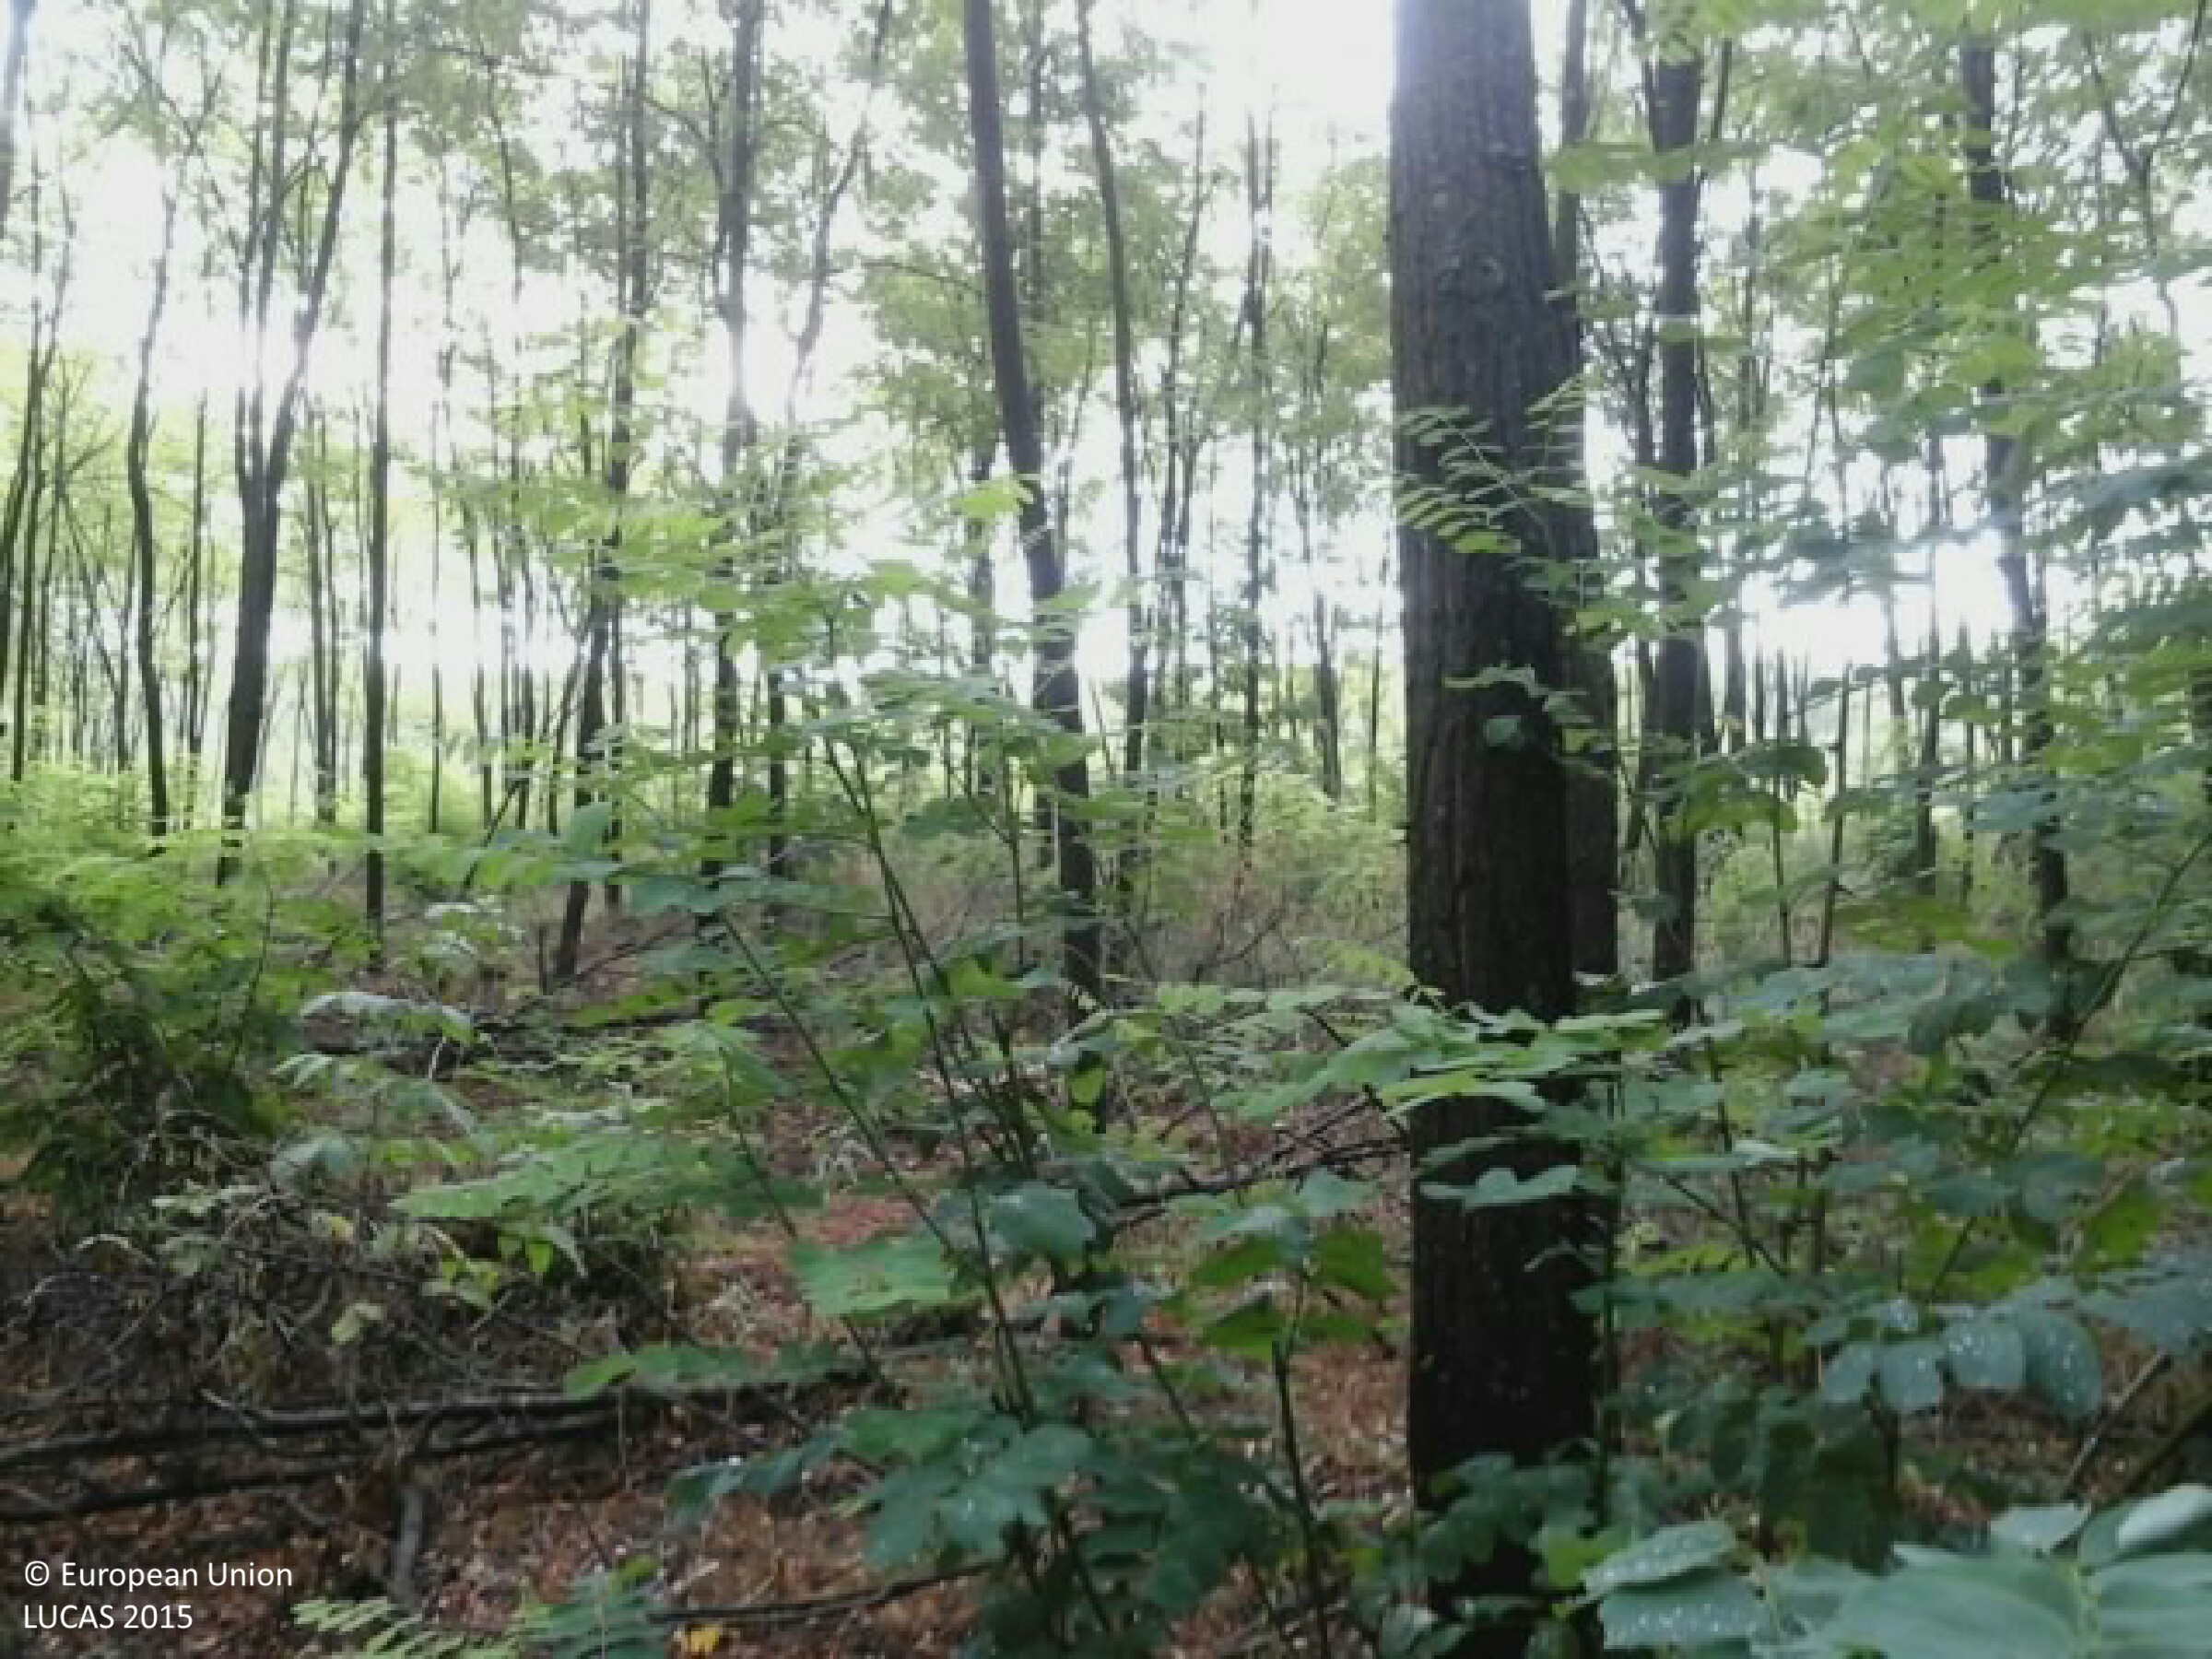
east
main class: Woodland
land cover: Broadleaved woodland
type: exotic forest
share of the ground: > 75 %
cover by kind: broadleaved forest trees 85 %, shrubs 10 %, herbaceous plants 5 %
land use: Forestry
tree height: > 5 m
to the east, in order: Broadleaved woodland; Tracks; Grass margins; Electric lines; Grass margins; Fences; Other fruit trees and berries; Fences; Spontaneously vegetated surfaces; Broadleaved woodland
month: August
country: HU
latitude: 47.1364
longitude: 19.7658
